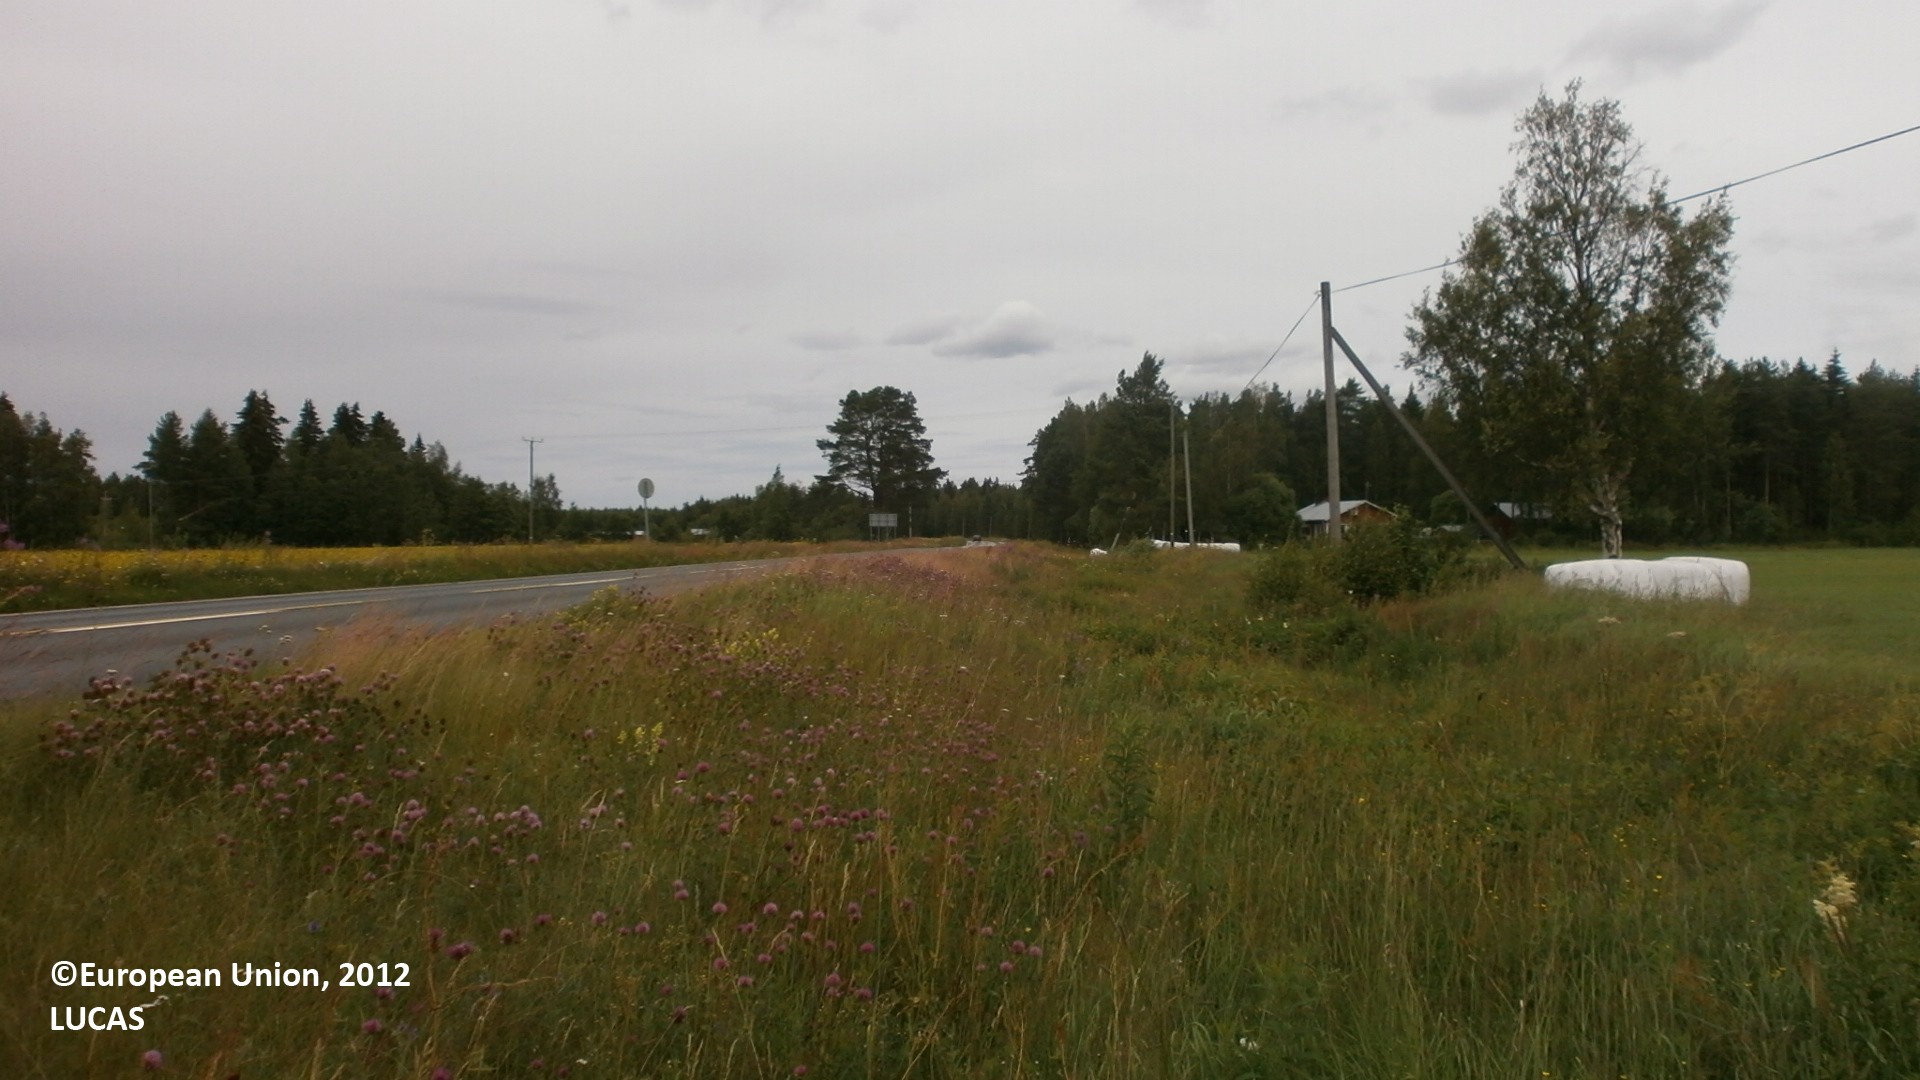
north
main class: Grassland
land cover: Spontaneously vegetated surfaces
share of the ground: > 75 %
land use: Road transport
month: July
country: FI
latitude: 63.9878
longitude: 24.2742
